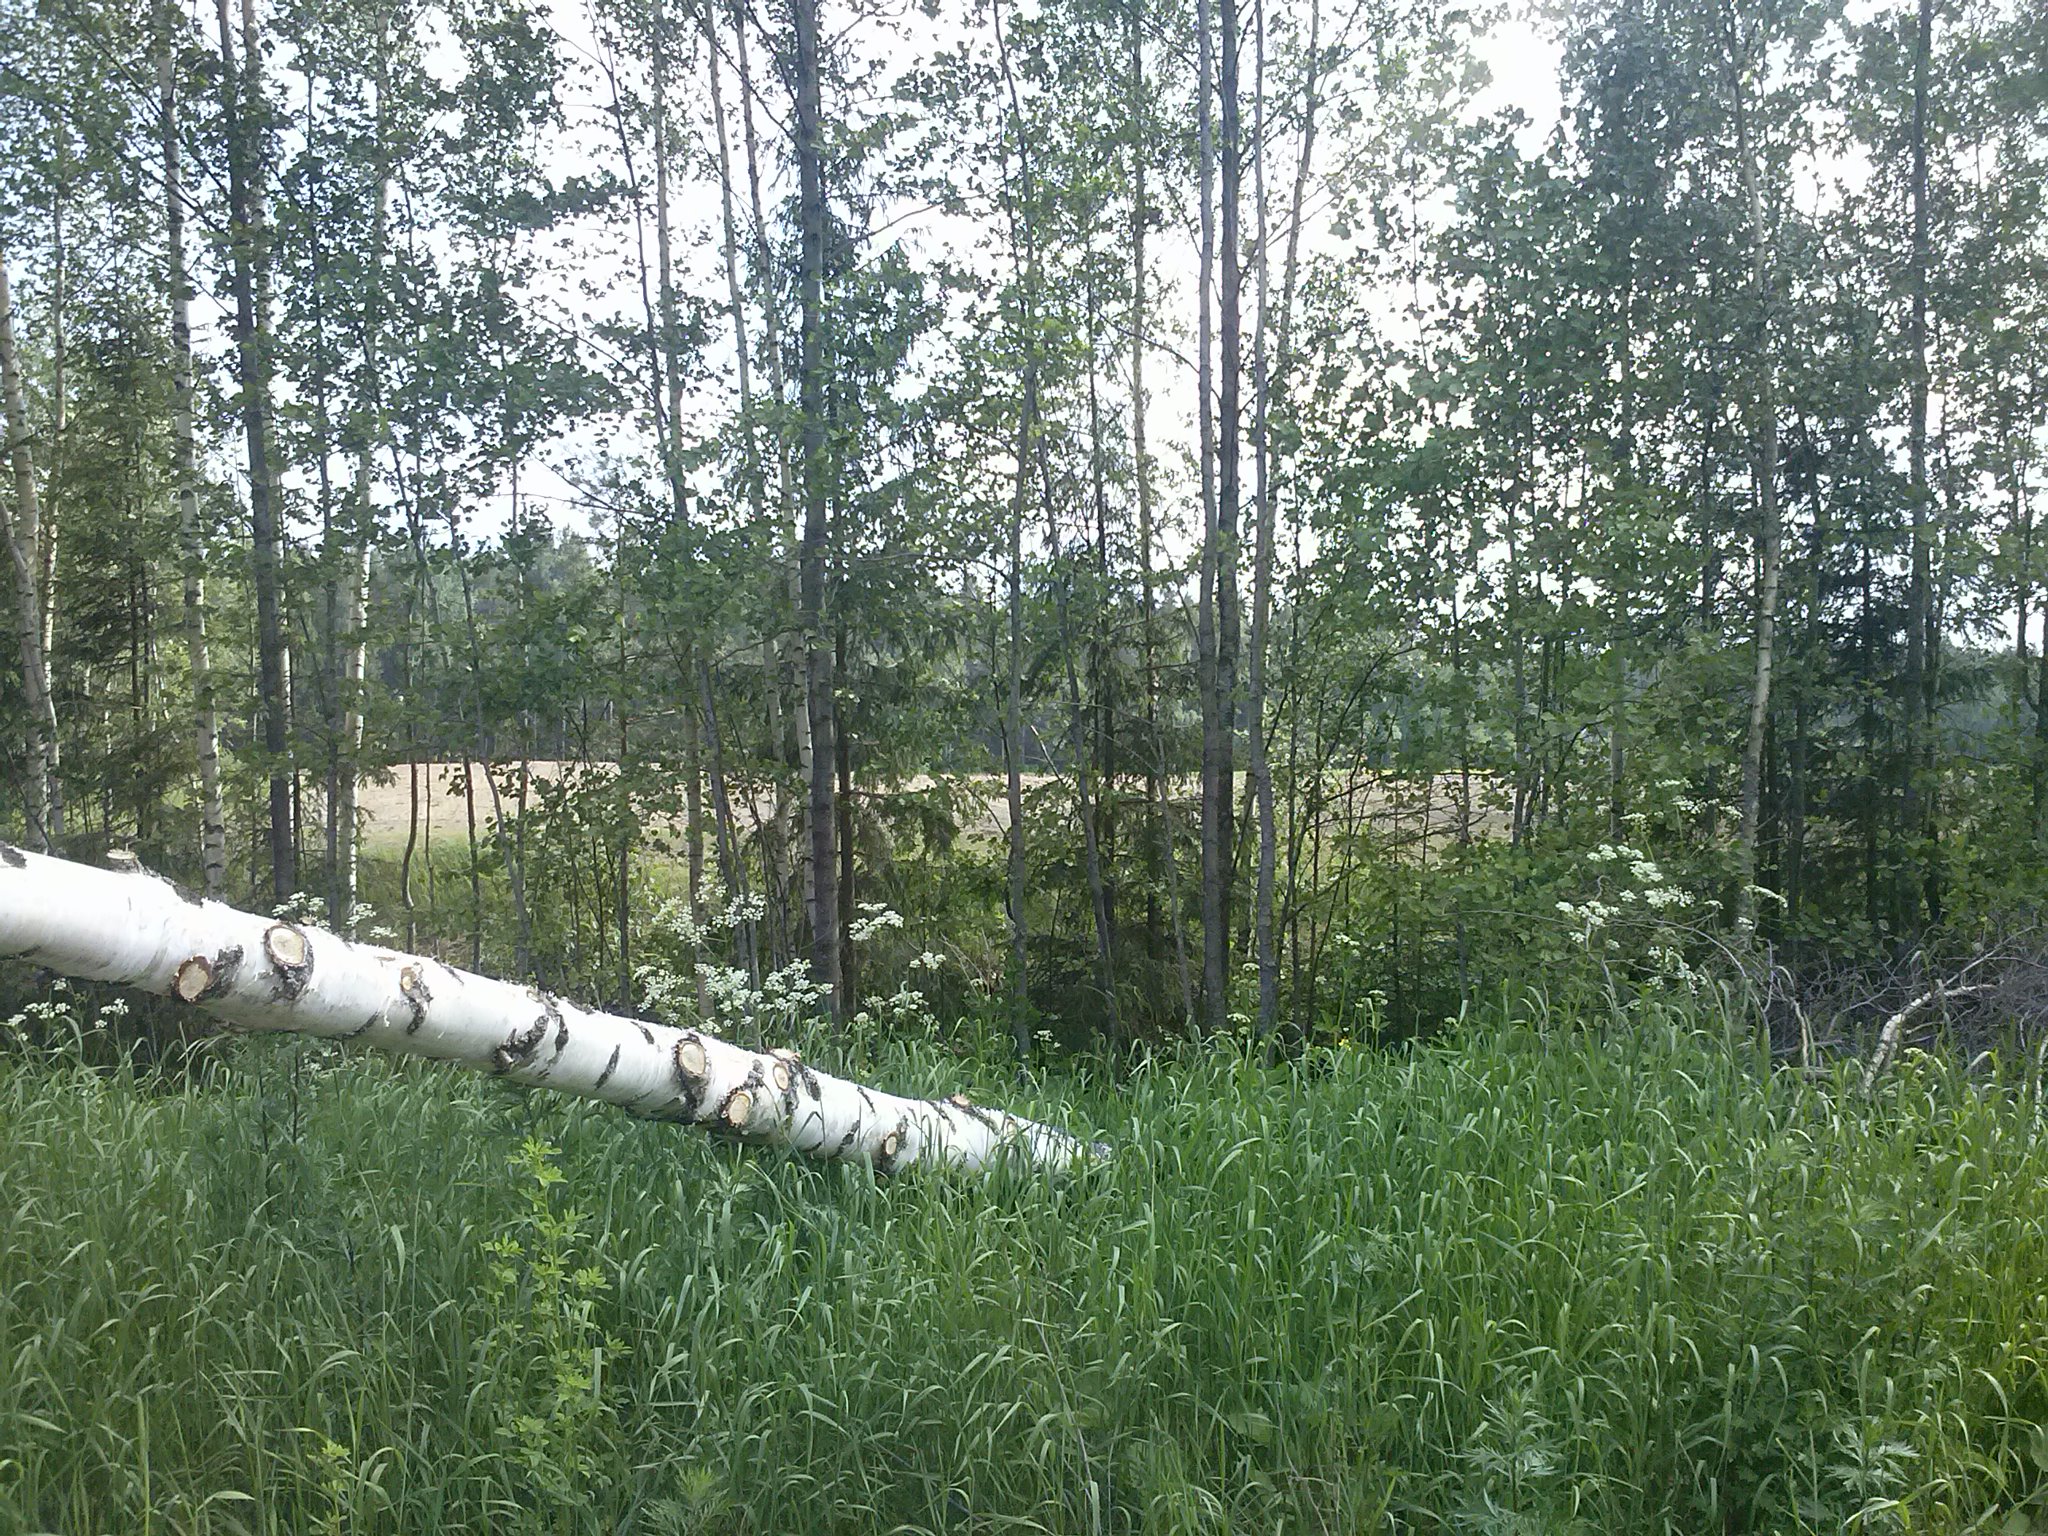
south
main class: Grassland
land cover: Grassland without tree/shrub cover
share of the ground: 50 - 75 %
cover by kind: herbaceous plants 70 %, unconsolidated bare surface 30 %
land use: Agriculture (excluding fallow land and kitchen gardens)
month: June
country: LV
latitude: 56.8606
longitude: 27.1751
